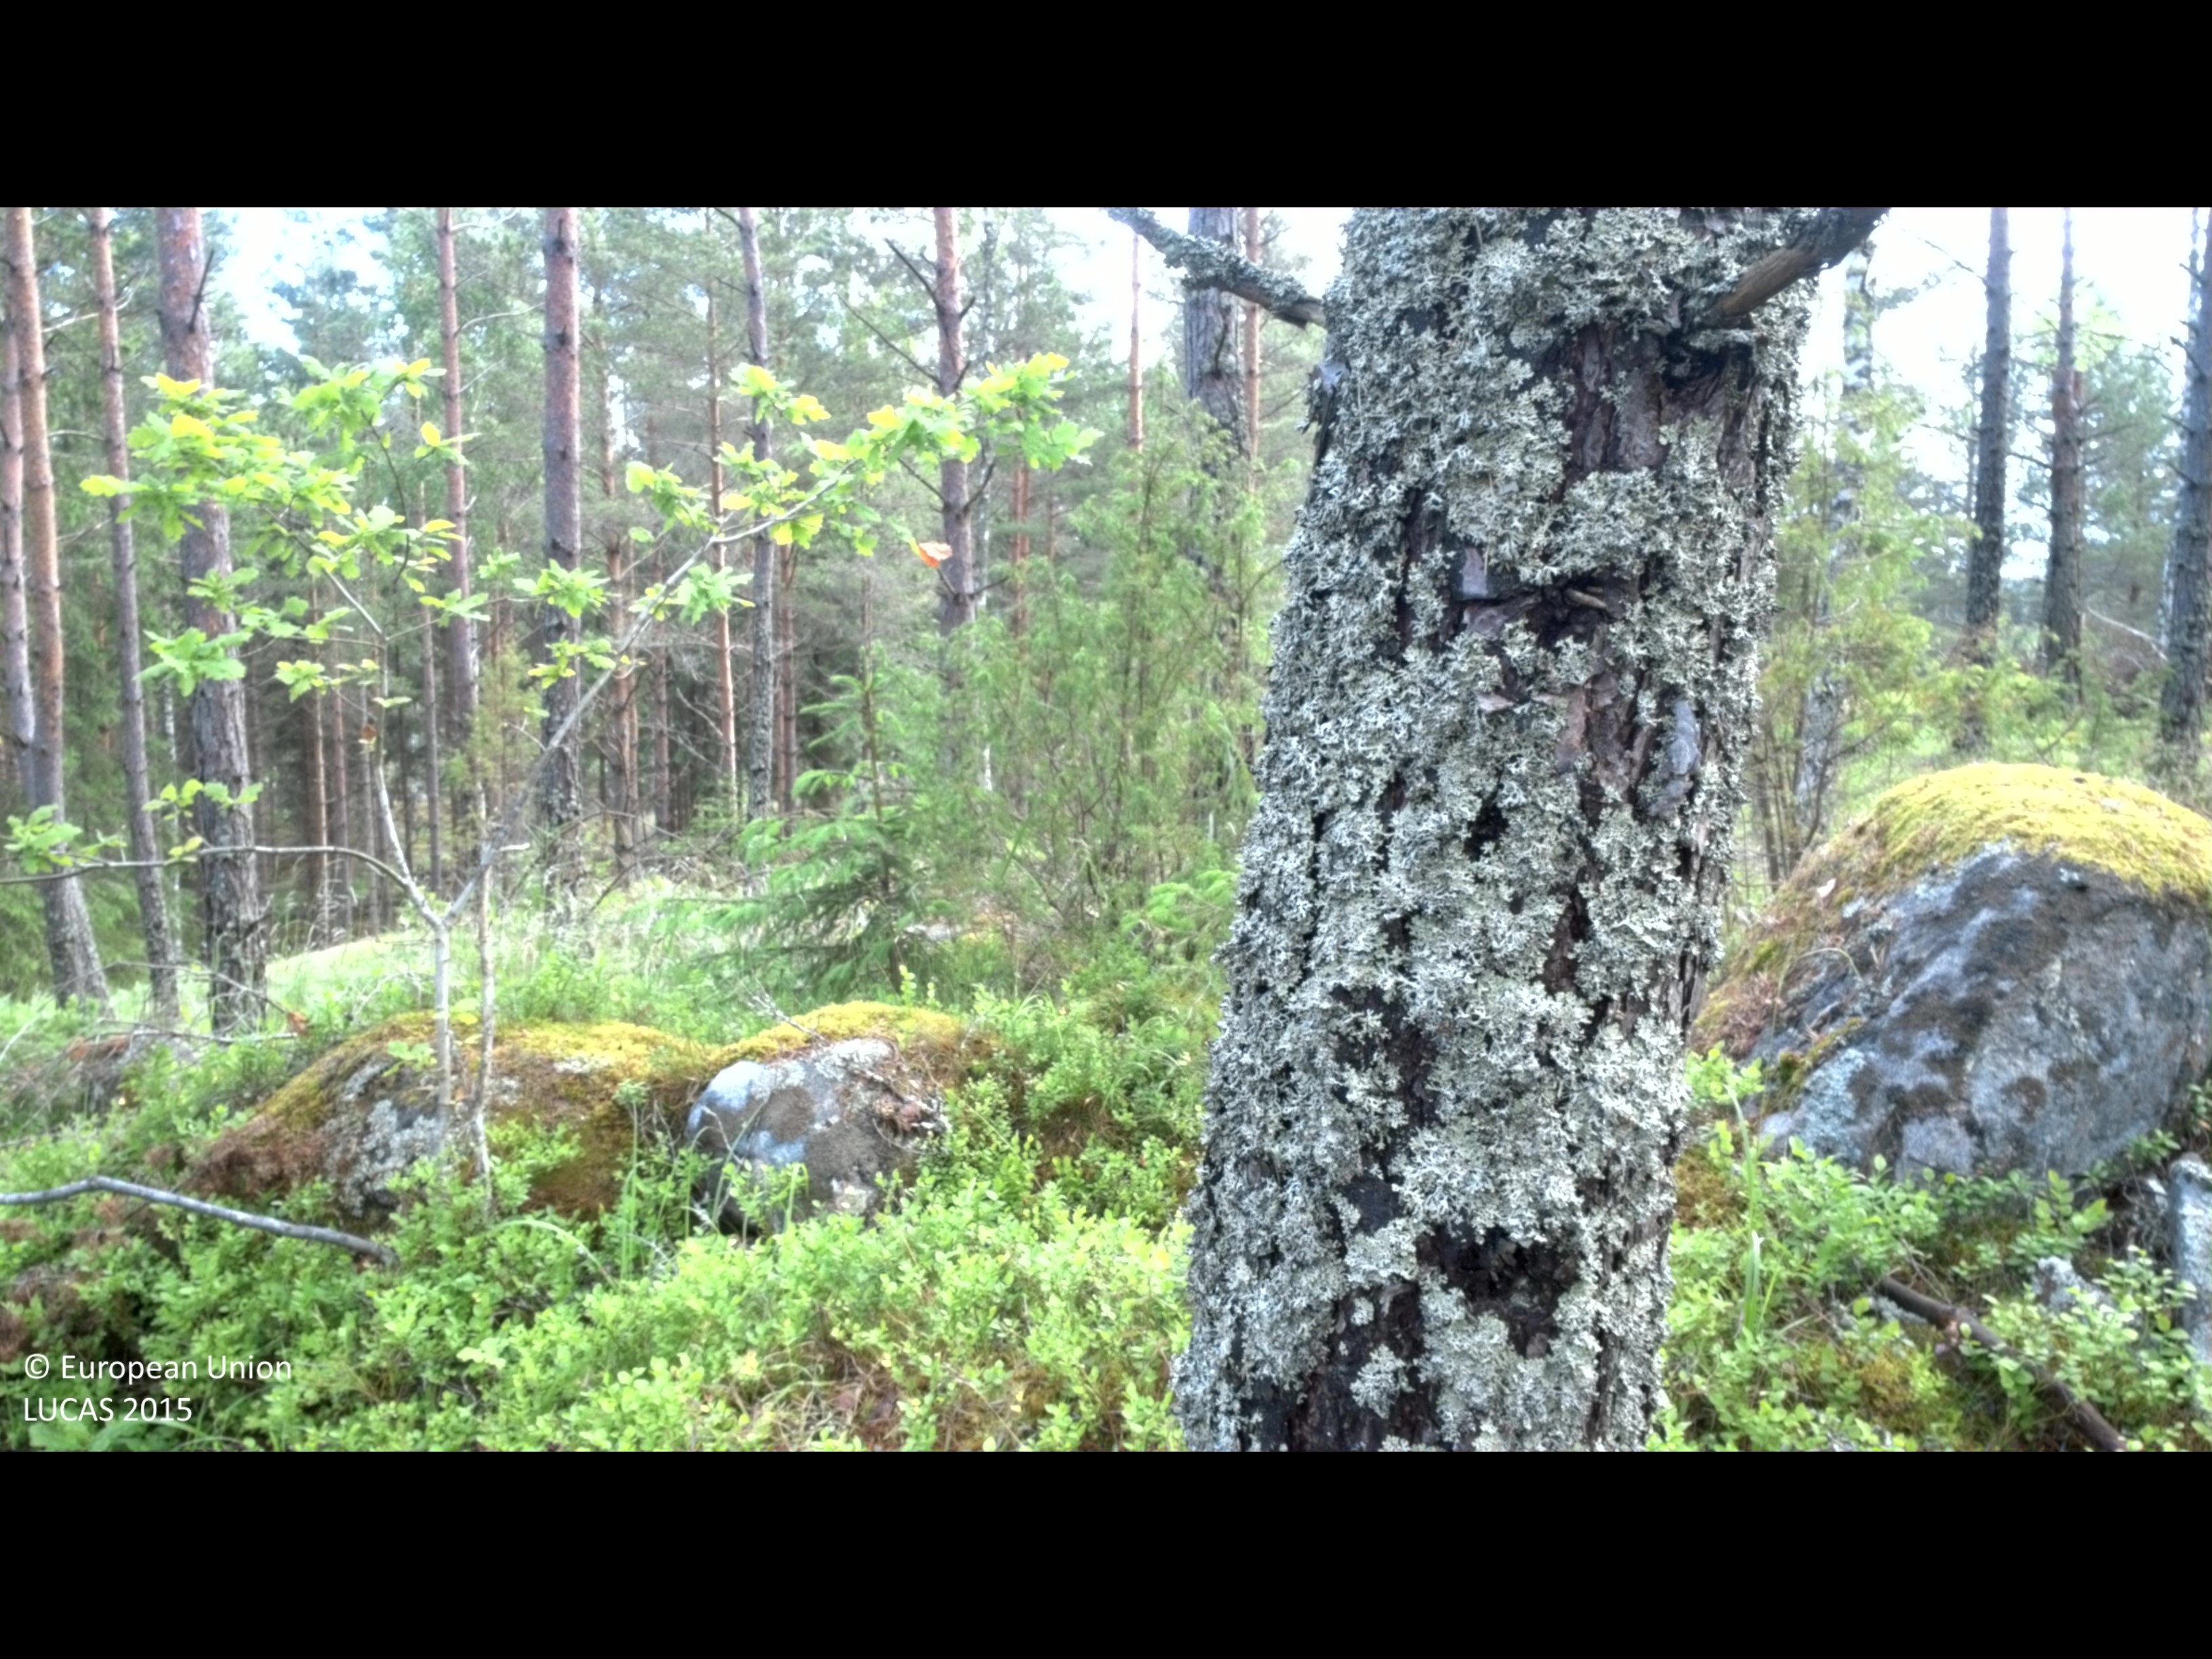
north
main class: Woodland
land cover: Pine dominated coniferous woodland
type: boreal forest
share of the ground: 50 - 75 %
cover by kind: coniferous forest trees 60 %, shrubs 25 %, broadleaved forest trees 10 %, lichens and mosses 5 %
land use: Forestry
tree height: > 5 m
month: June
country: SE
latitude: 57.8513
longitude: 16.3838
